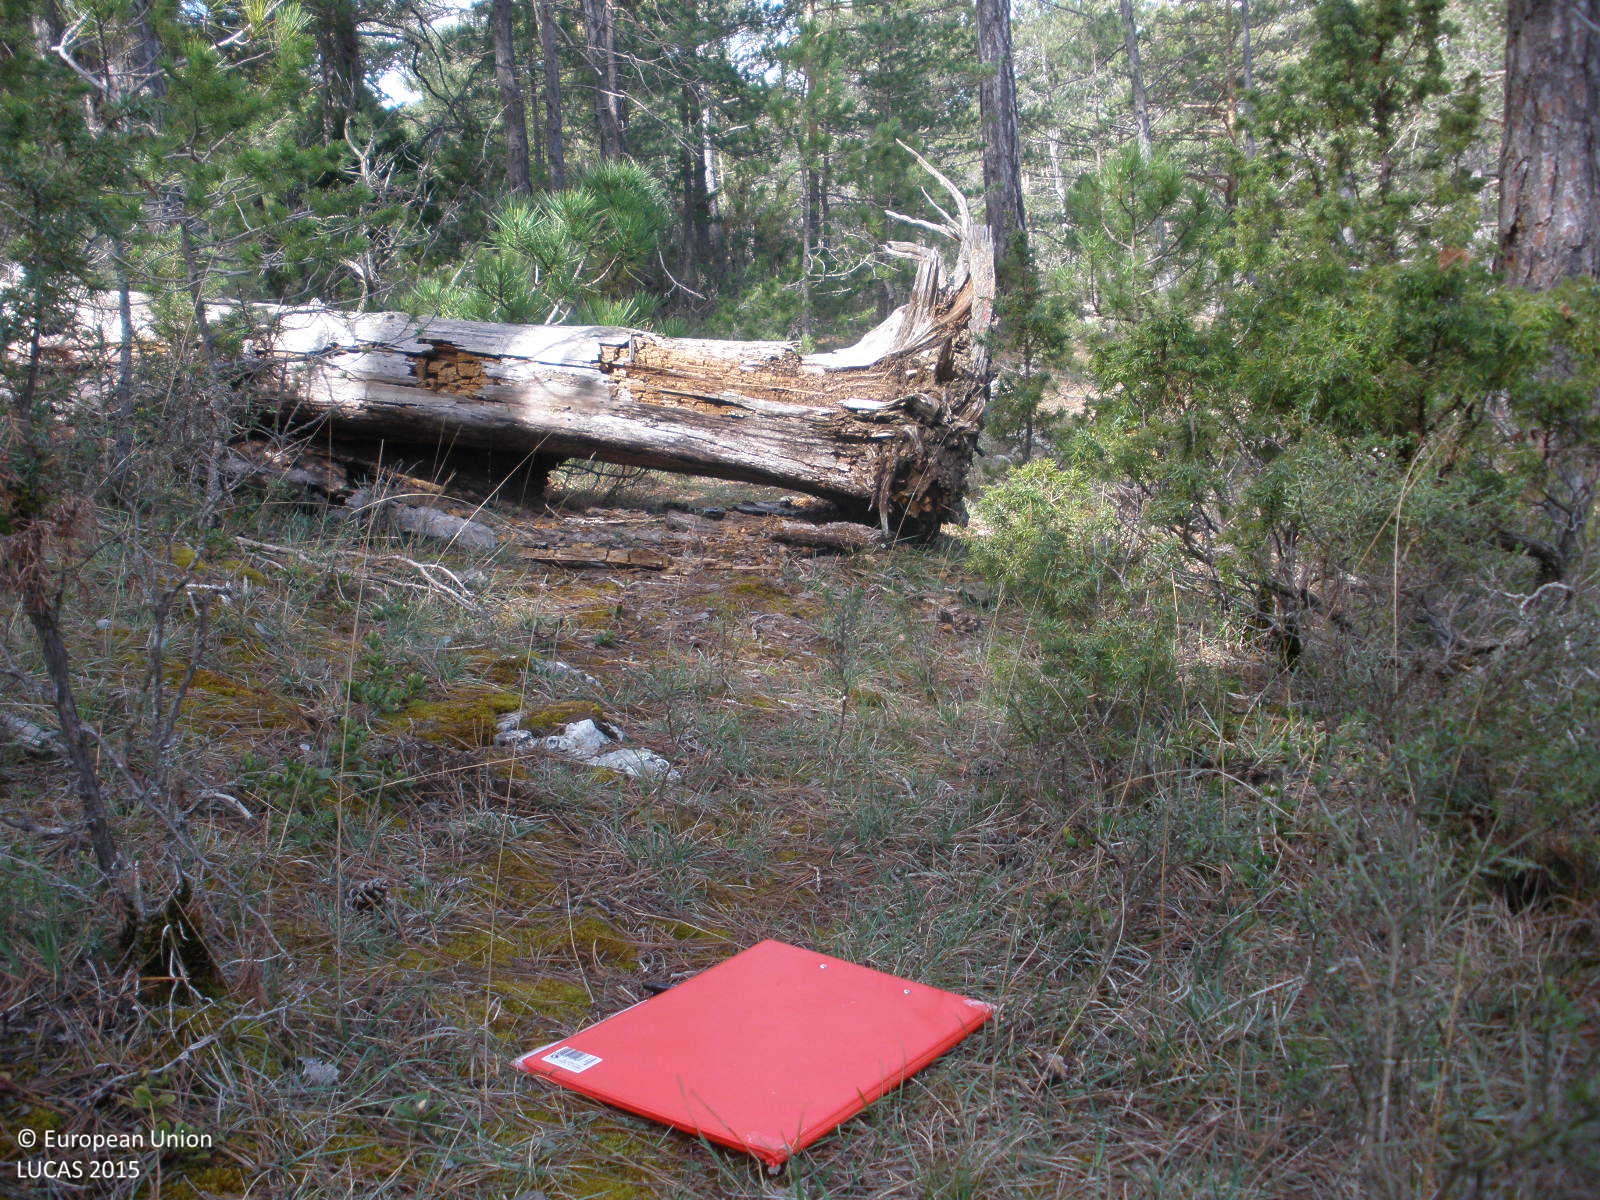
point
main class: Woodland
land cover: Pine dominated coniferous woodland
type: coniferous forest of the mediterranean region
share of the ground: > 75 %
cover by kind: coniferous forest trees 75 %, shrubs 15 %, herbaceous plants 10 %
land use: Semi-natural and natural areas not in use
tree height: > 5 m
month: April
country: ES
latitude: 40.3513
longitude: -0.7342
